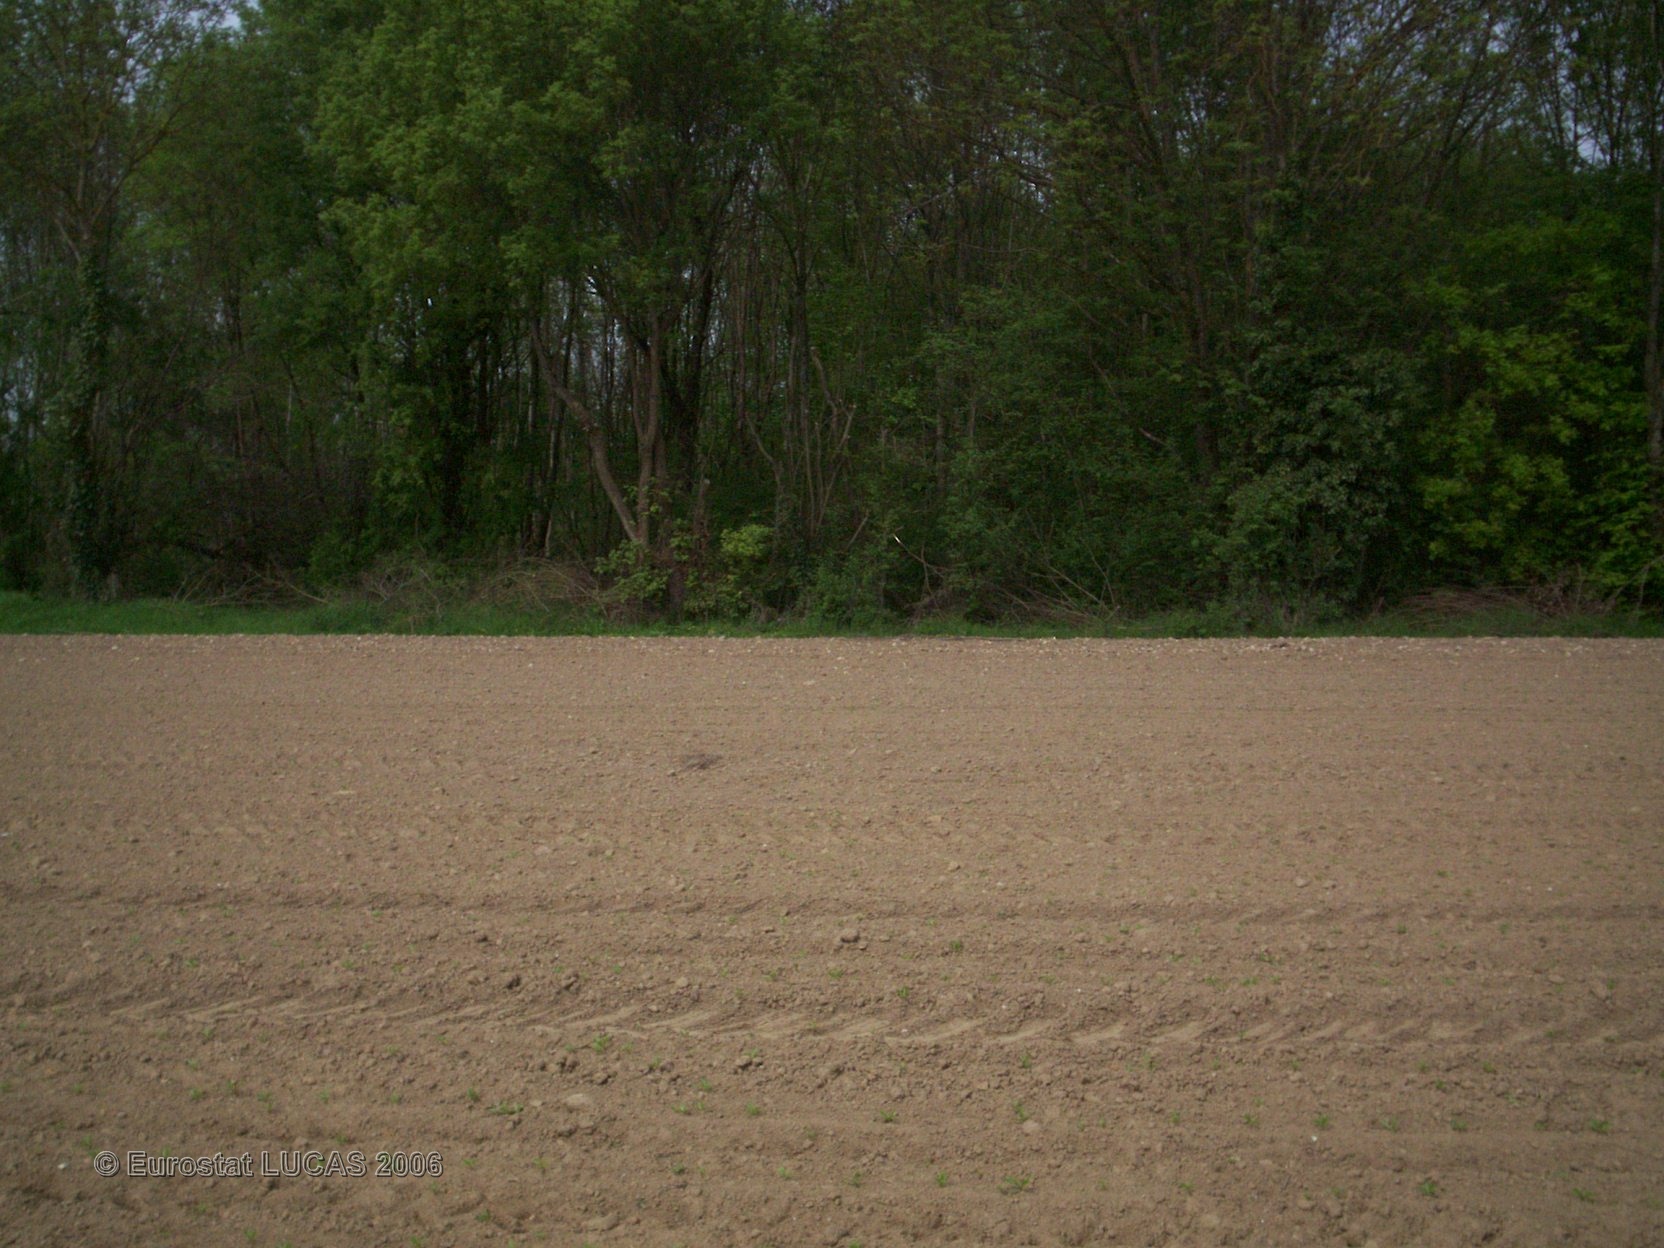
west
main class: Cropland
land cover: Sugar beet
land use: Agriculture (excluding fallow land and kitchen gardens)
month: May
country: FR
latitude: 48.6390
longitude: 2.8117
